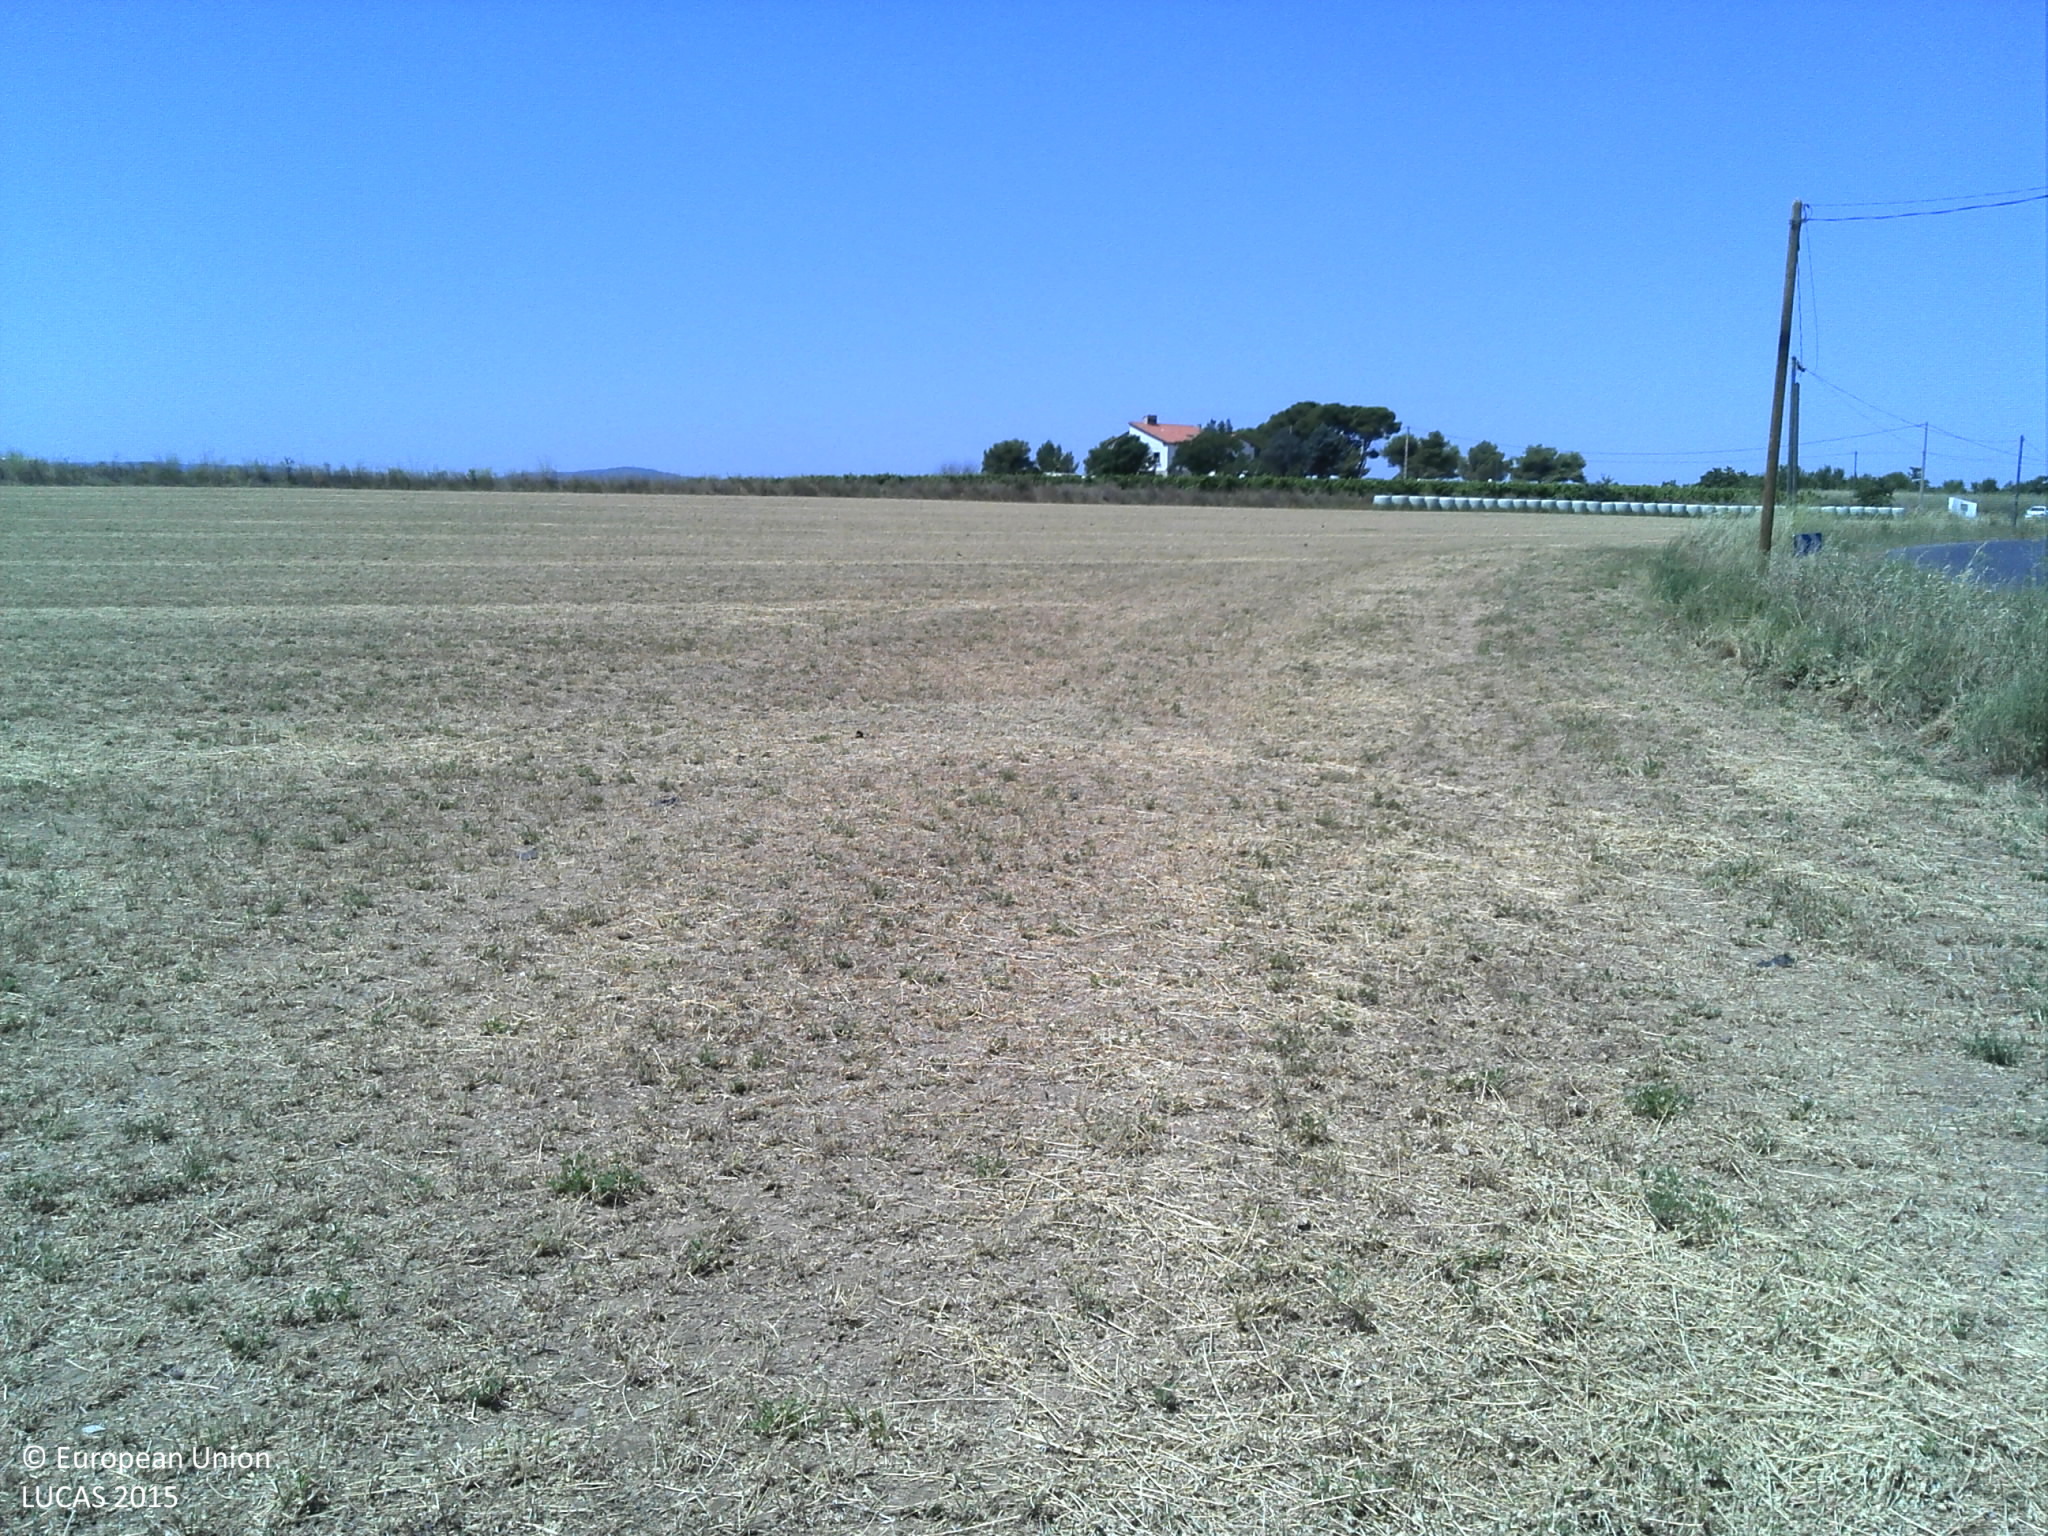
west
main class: Cropland
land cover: Temporary grasslands
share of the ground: > 75 %
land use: Agriculture (excluding fallow land and kitchen gardens)
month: July
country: FR
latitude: 43.5579
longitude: 3.9312
